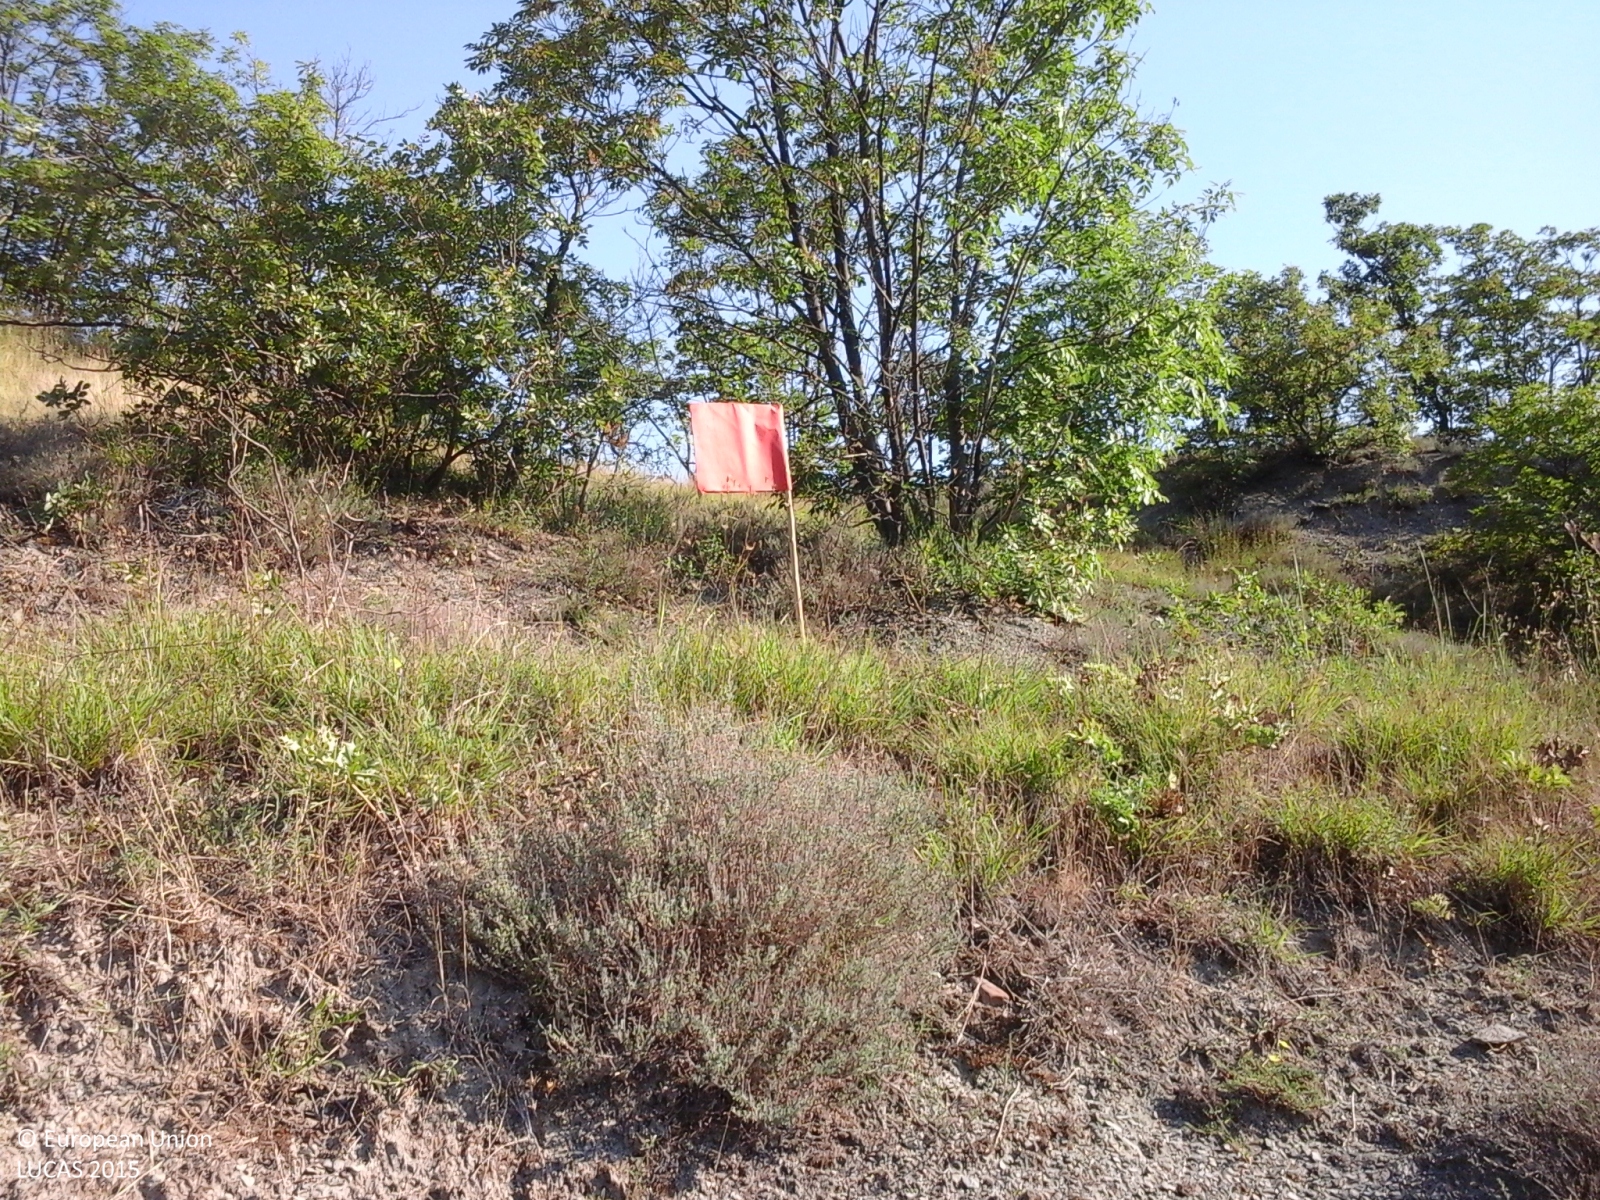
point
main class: Shrubland
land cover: Shrubland with sparse tree cover
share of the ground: > 75 %
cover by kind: herbaceous plants 50 %, consolidated bare surface 25 %, shrubs 20 %, broadleaved forest trees 5 %
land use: Semi-natural and natural areas not in use
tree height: < 5 m
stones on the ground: > 50 %
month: June
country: IT
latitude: 44.5716
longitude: 8.3287
